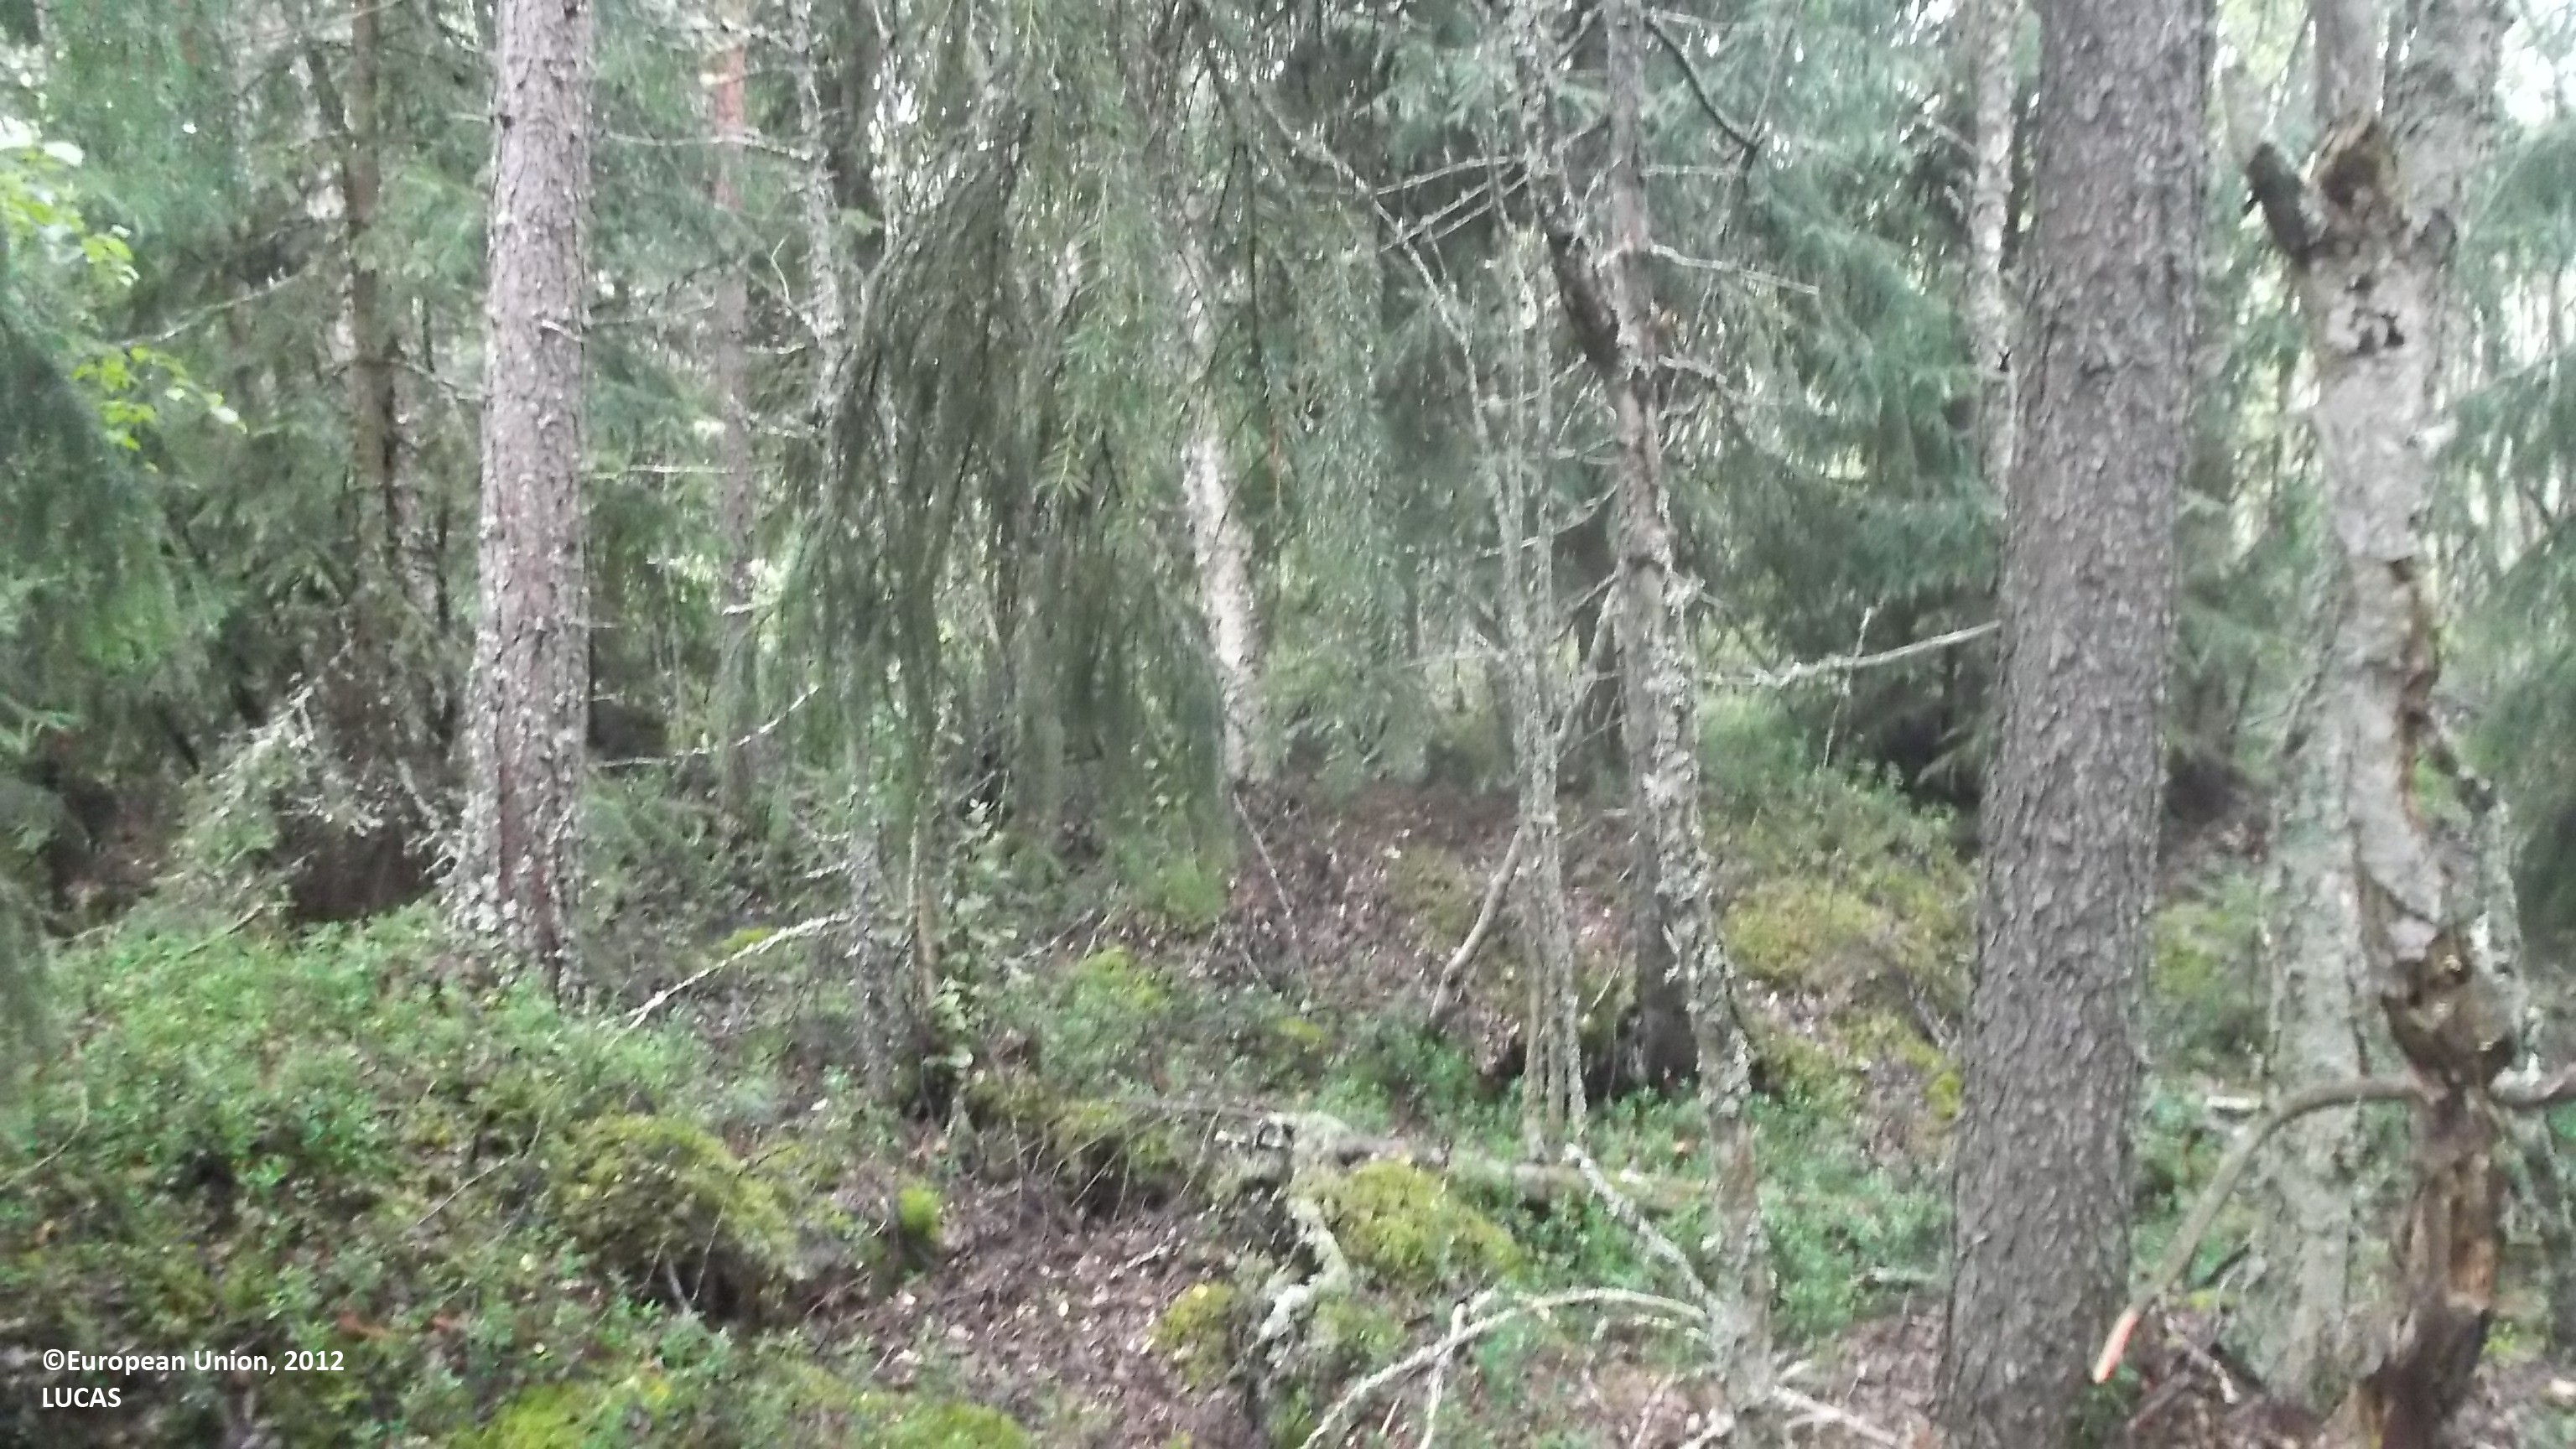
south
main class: Woodland
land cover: Other mixed woodland
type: boreal forest
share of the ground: > 75 %
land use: Forestry
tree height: > 5 m
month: August
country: FI
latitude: 63.8010
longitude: 23.2718
